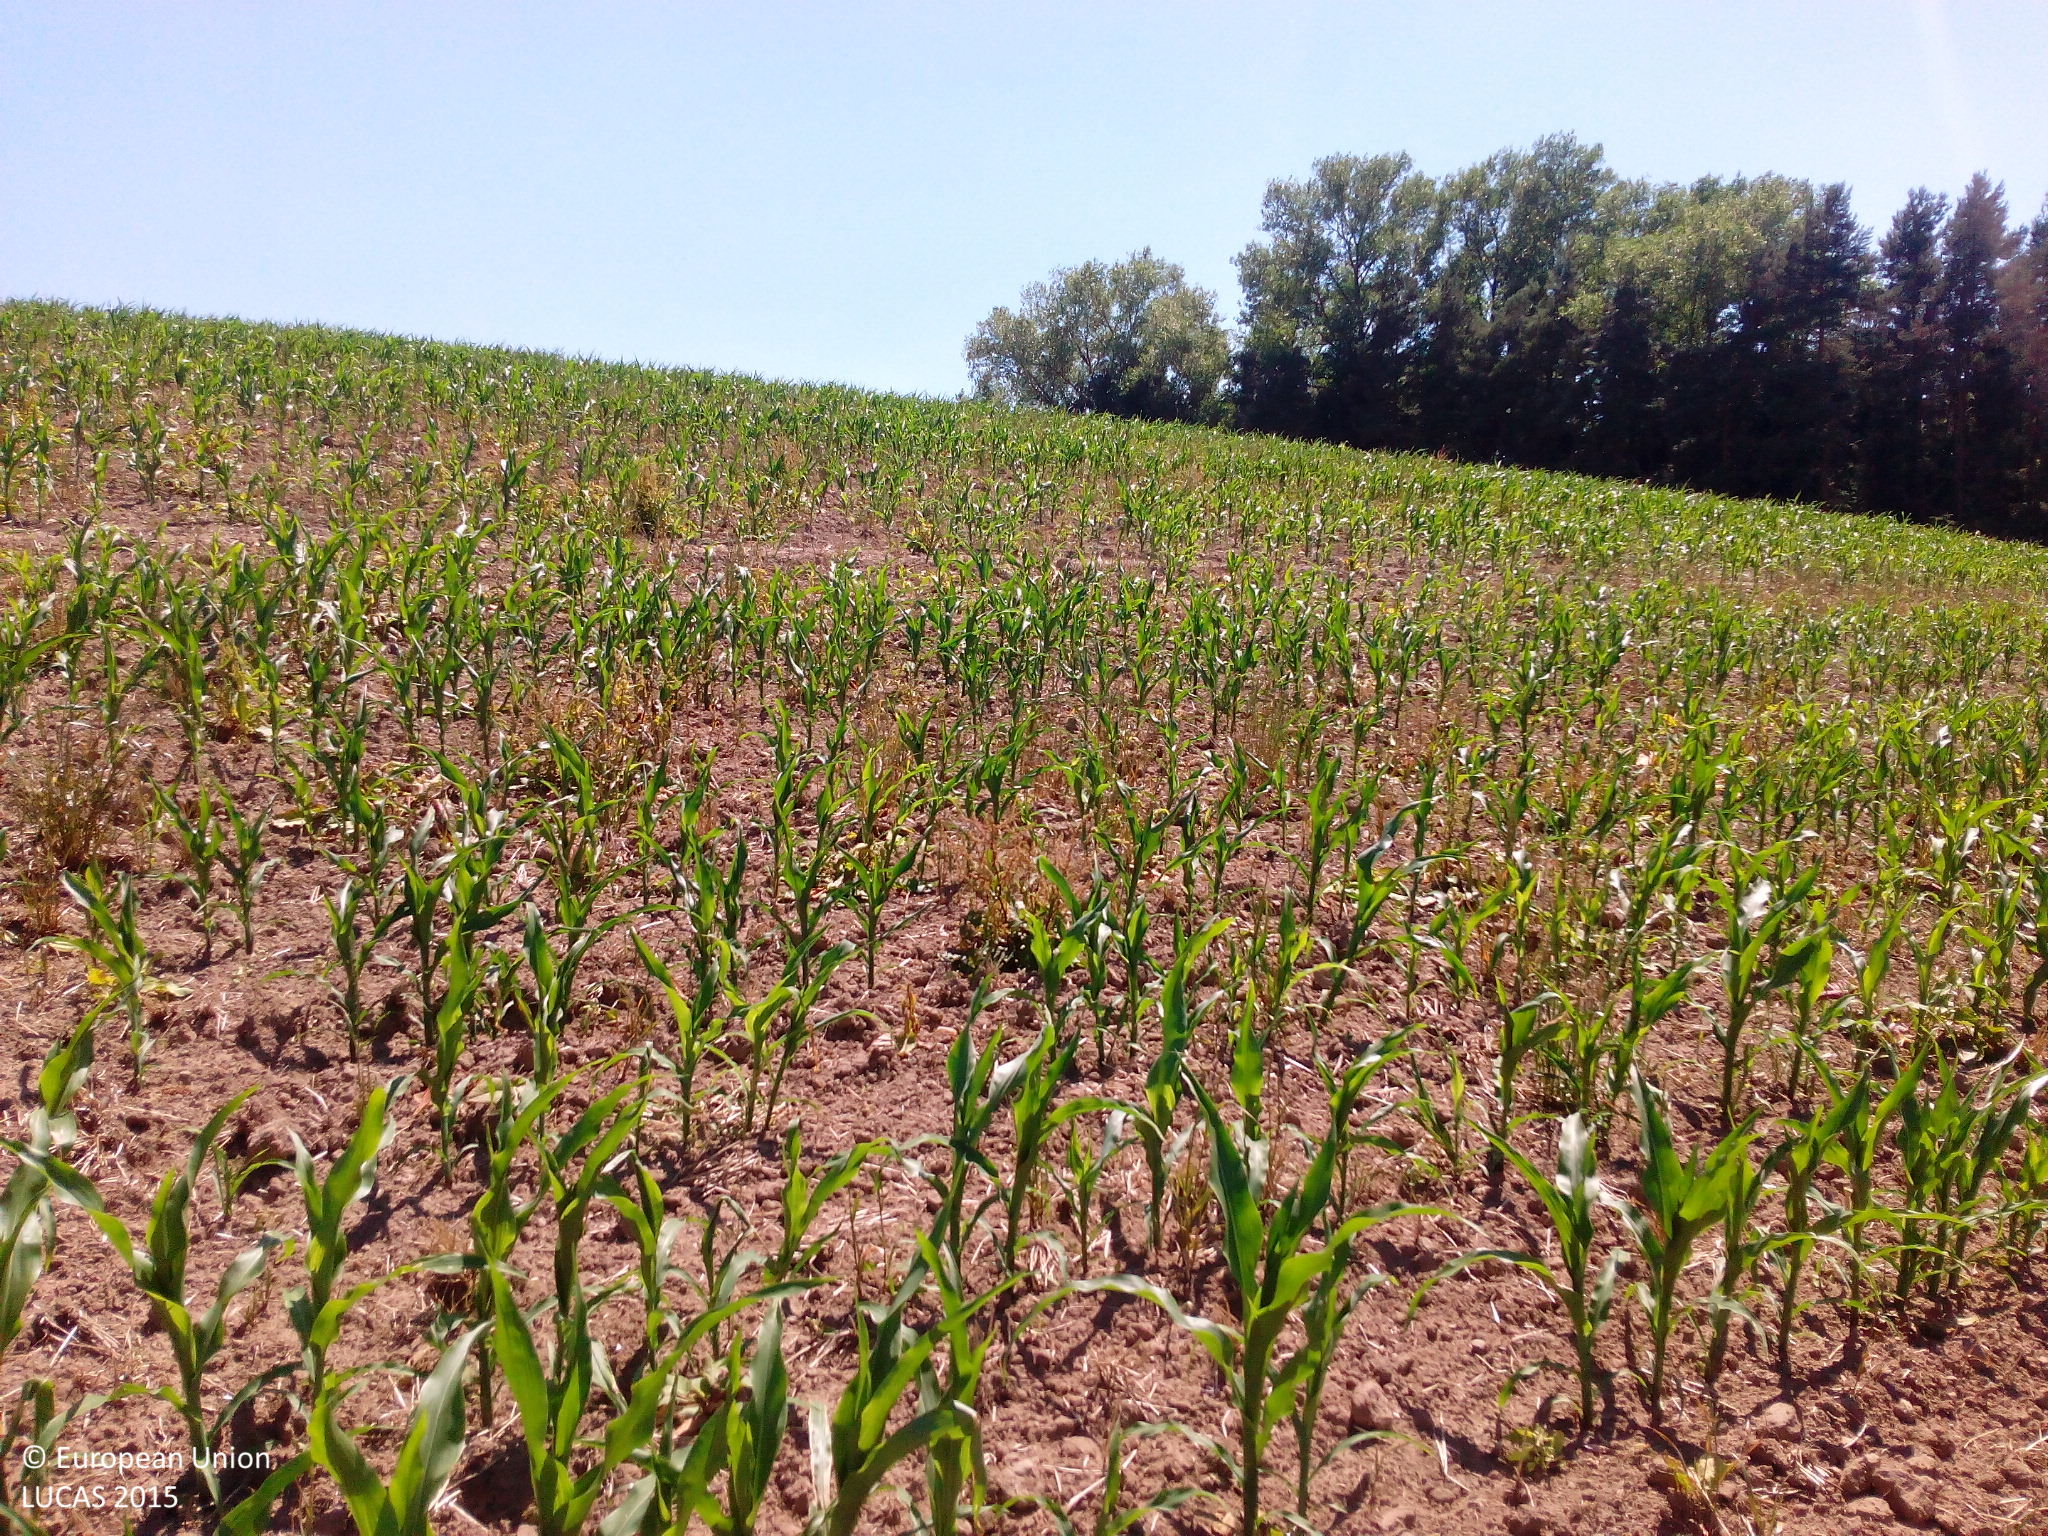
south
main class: Cropland
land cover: Maize
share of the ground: 25 - 50 %
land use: Agriculture (excluding fallow land and kitchen gardens)
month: July
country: DE
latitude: 50.3071
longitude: 10.8282
